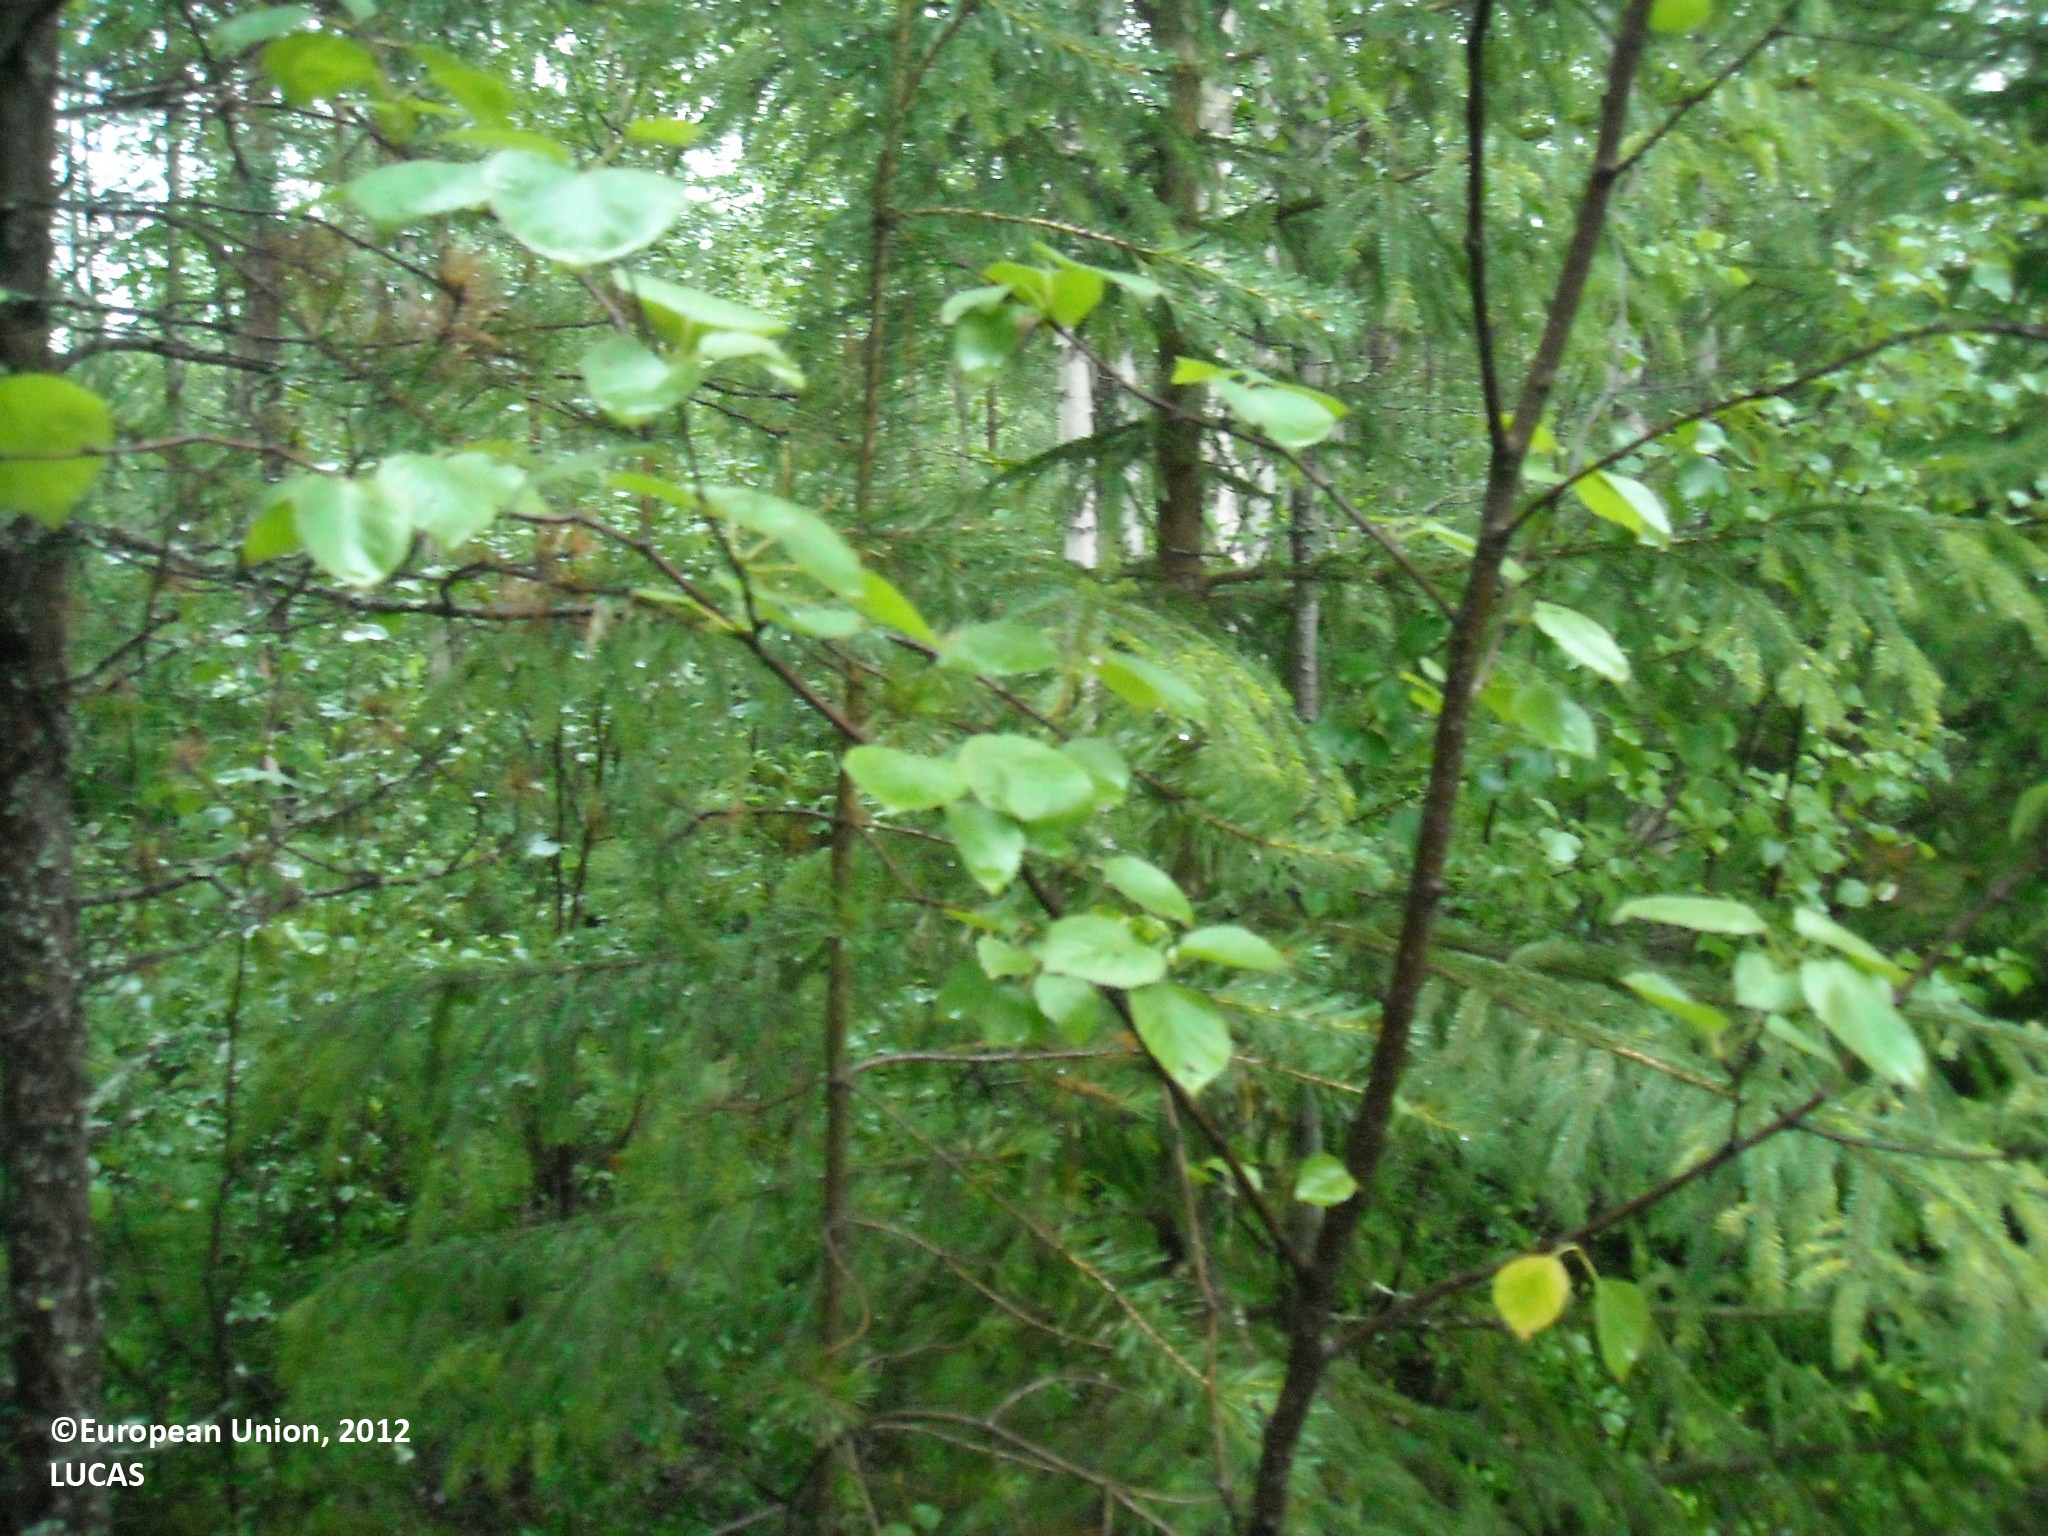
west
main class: Woodland
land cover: Other mixed woodland
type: boreal forest
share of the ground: > 75 %
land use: Forestry
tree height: > 5 m
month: July
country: FI
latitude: 65.0039
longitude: 27.5948
